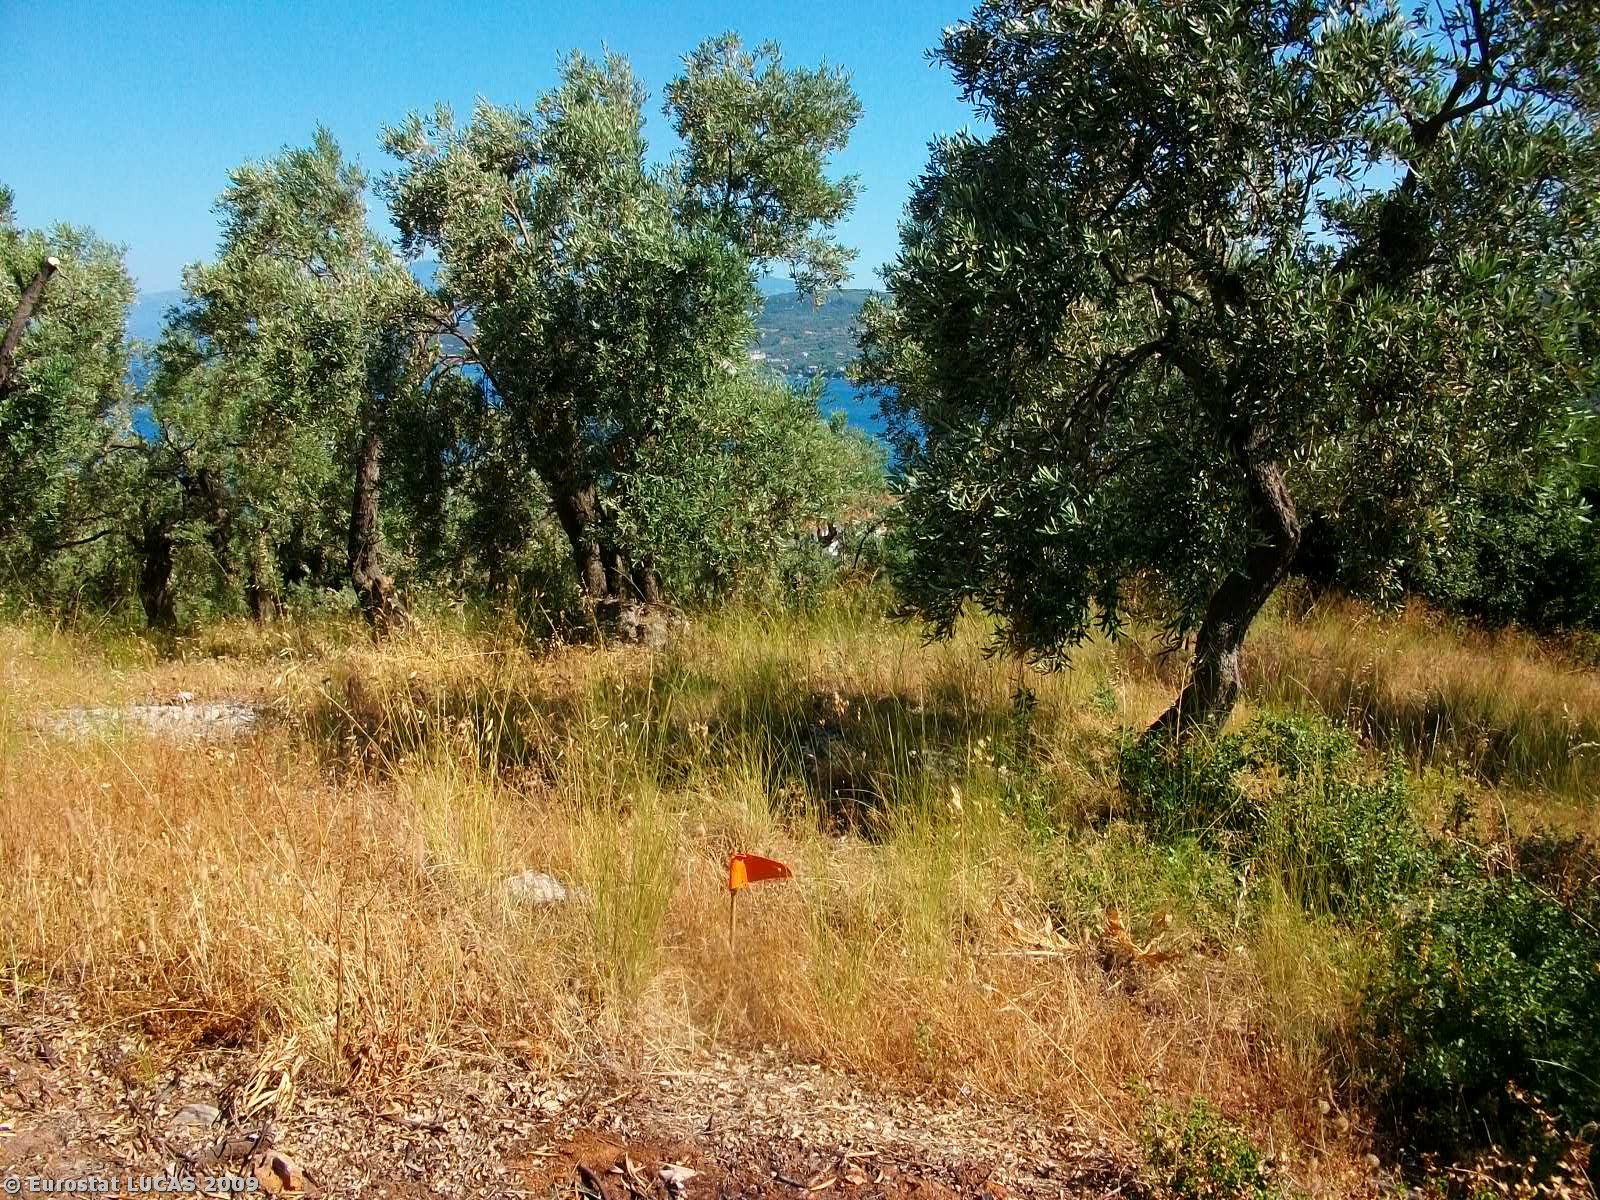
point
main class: Cropland
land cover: Olive groves
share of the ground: 50 - 75 %
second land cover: Grassland with sparse tree/shrub cover
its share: > 75 %
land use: Agriculture (excluding fallow land and kitchen gardens)
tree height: < 5 m
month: June
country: GR
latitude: 39.1669
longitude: 23.2208
